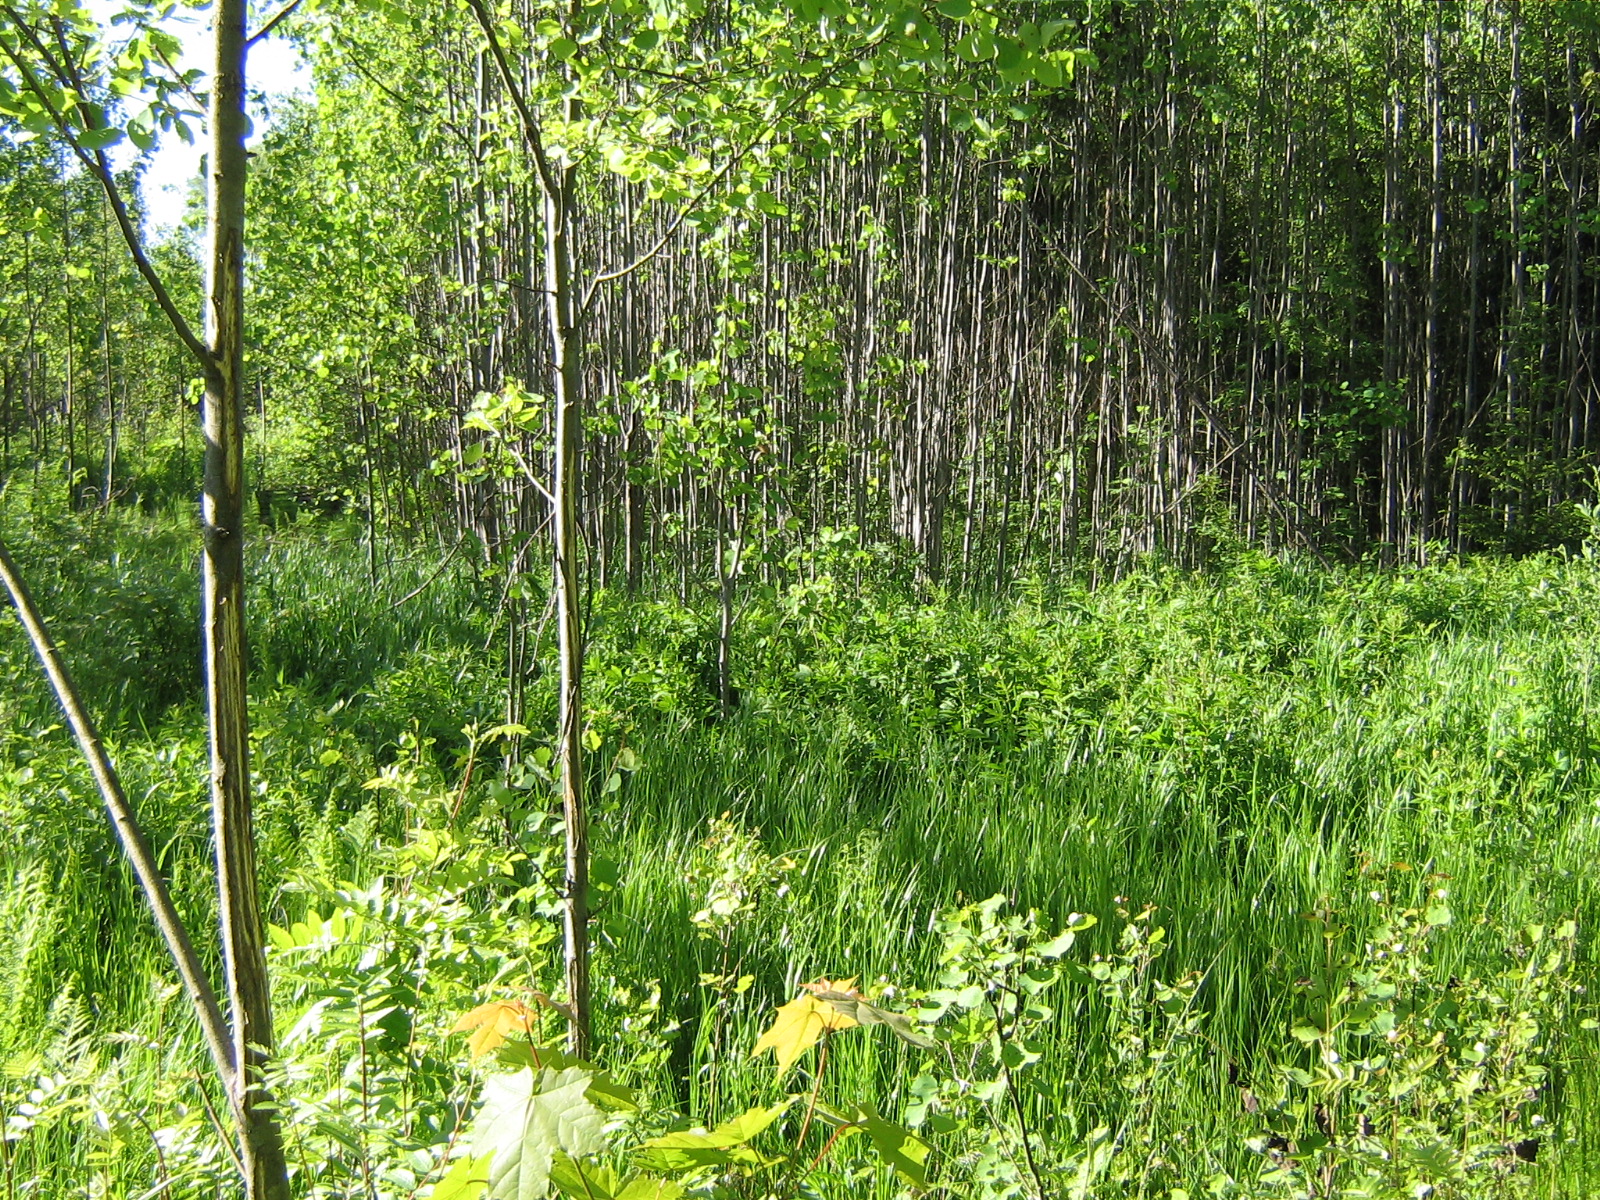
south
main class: Woodland
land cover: Broadleaved woodland
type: non-riverine alder, birch or aspen forest
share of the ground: > 75 %
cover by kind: broadleaved forest trees 75 %, herbaceous plants 15 %, shrubs 10 %
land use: Forestry
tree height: < 5 m
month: June
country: LV
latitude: 57.1189
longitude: 25.7302
